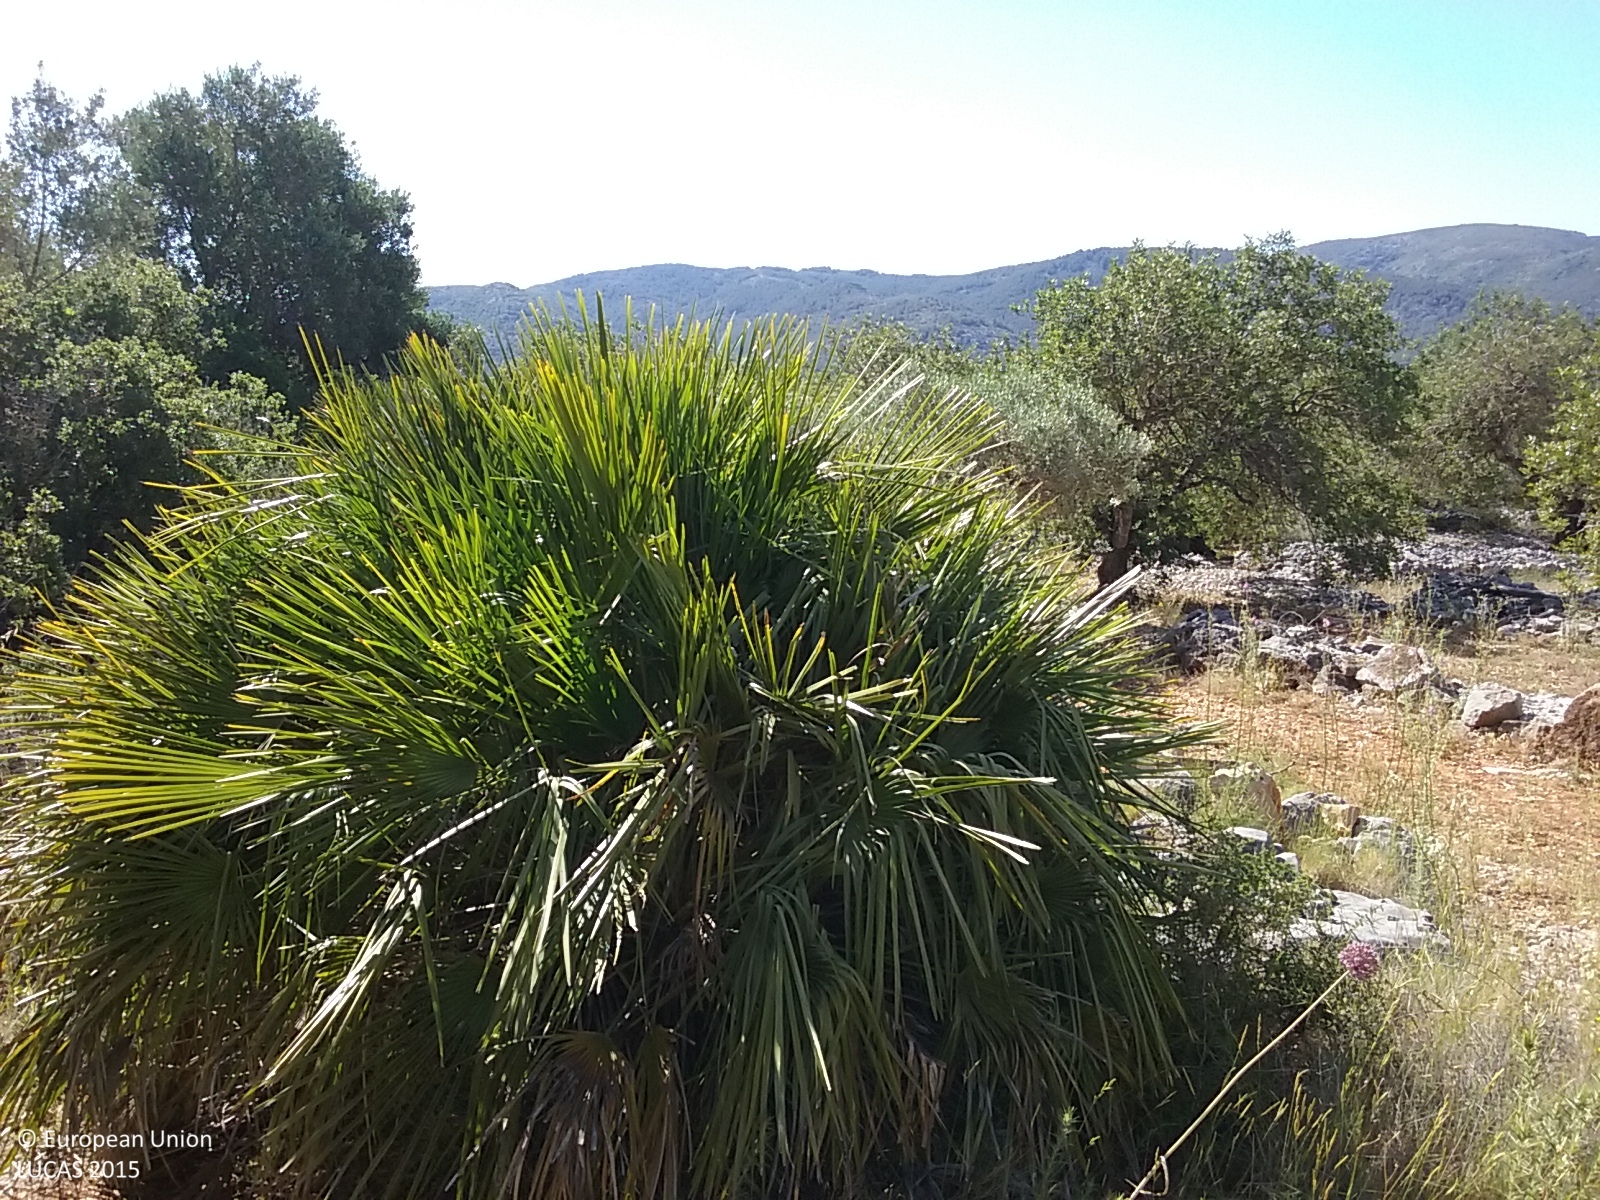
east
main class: Shrubland
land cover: Shrubland with sparse tree cover
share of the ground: > 75 %
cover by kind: shrubs 75 %, herbaceous plants 10 %, broadleaved forest trees 5 %
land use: Semi-natural and natural areas not in use
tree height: < 5 m
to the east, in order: Shrubland with sparse tree cover; Electric lines; Shrubland with sparse tree cover
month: May
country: ES
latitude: 40.3687
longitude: 0.3045
